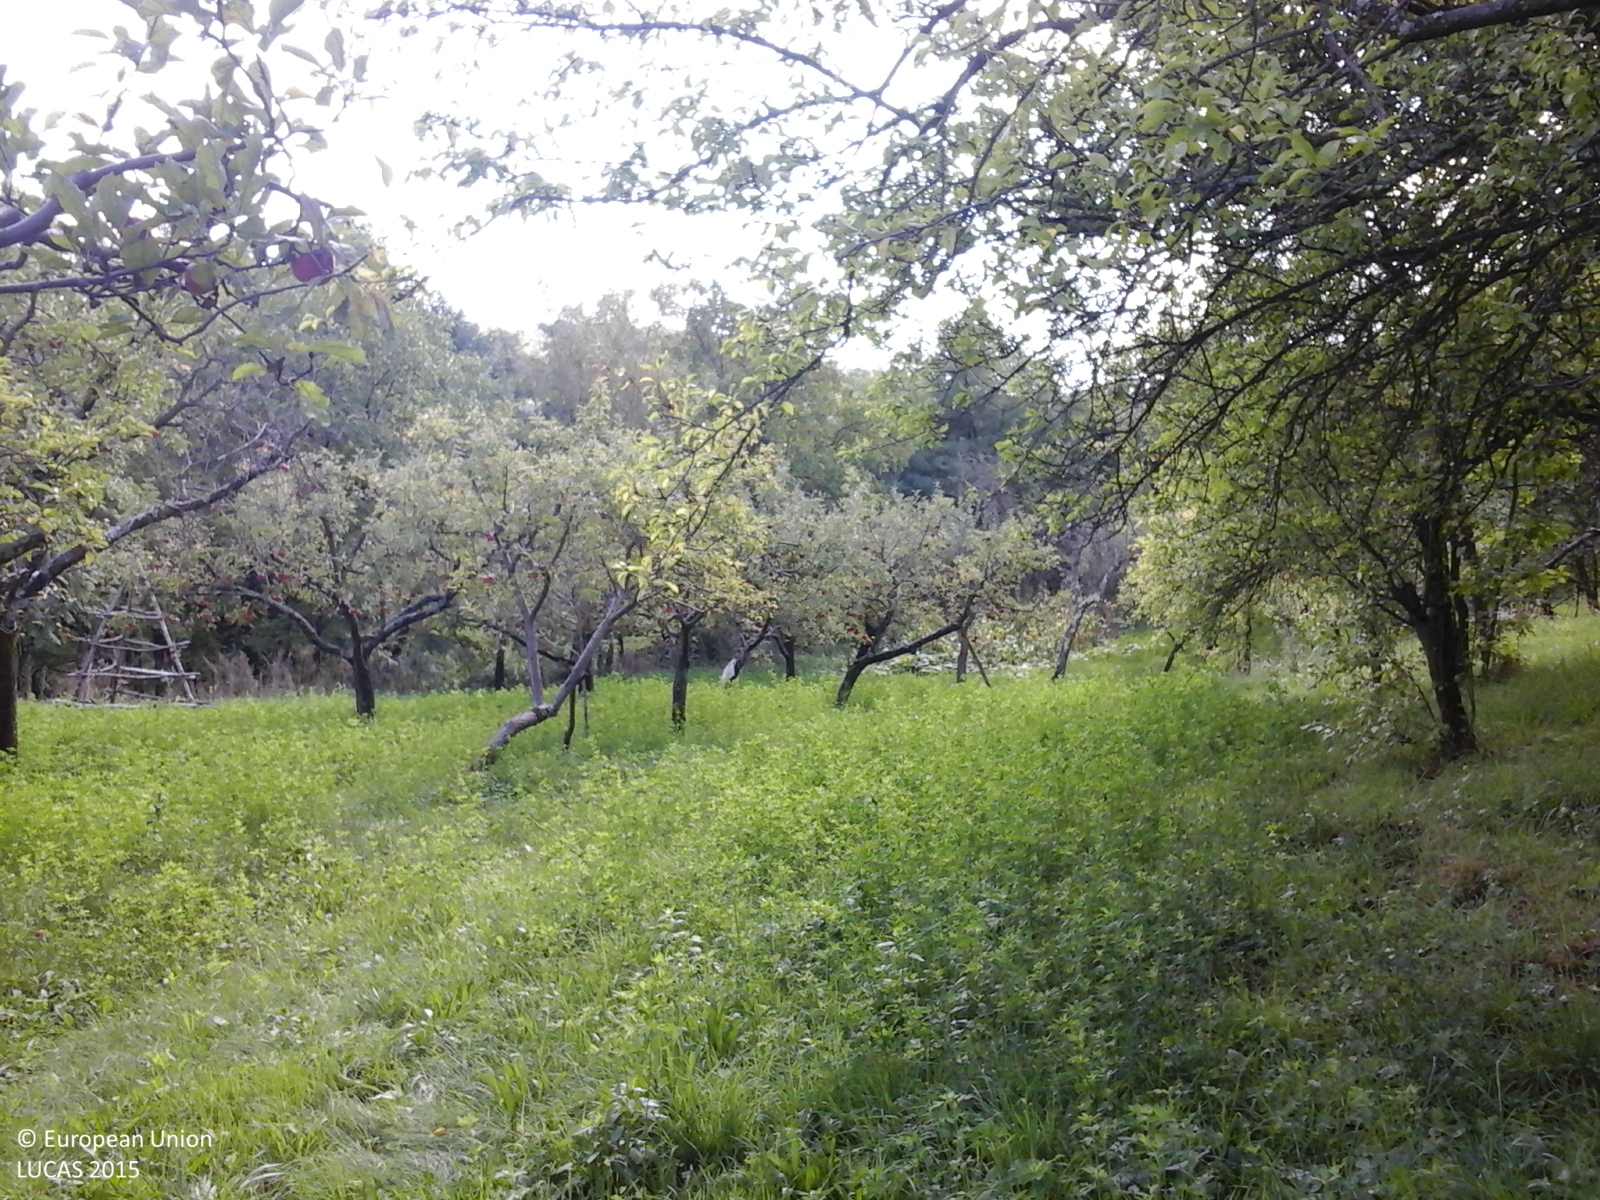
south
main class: Cropland
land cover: Apple fruit
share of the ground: 25 - 50 %
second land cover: Grassland without tree/shrub cover
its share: > 75 %
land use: Agriculture (excluding fallow land and kitchen gardens)
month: September
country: RO
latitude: 45.1888
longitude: 24.5234
